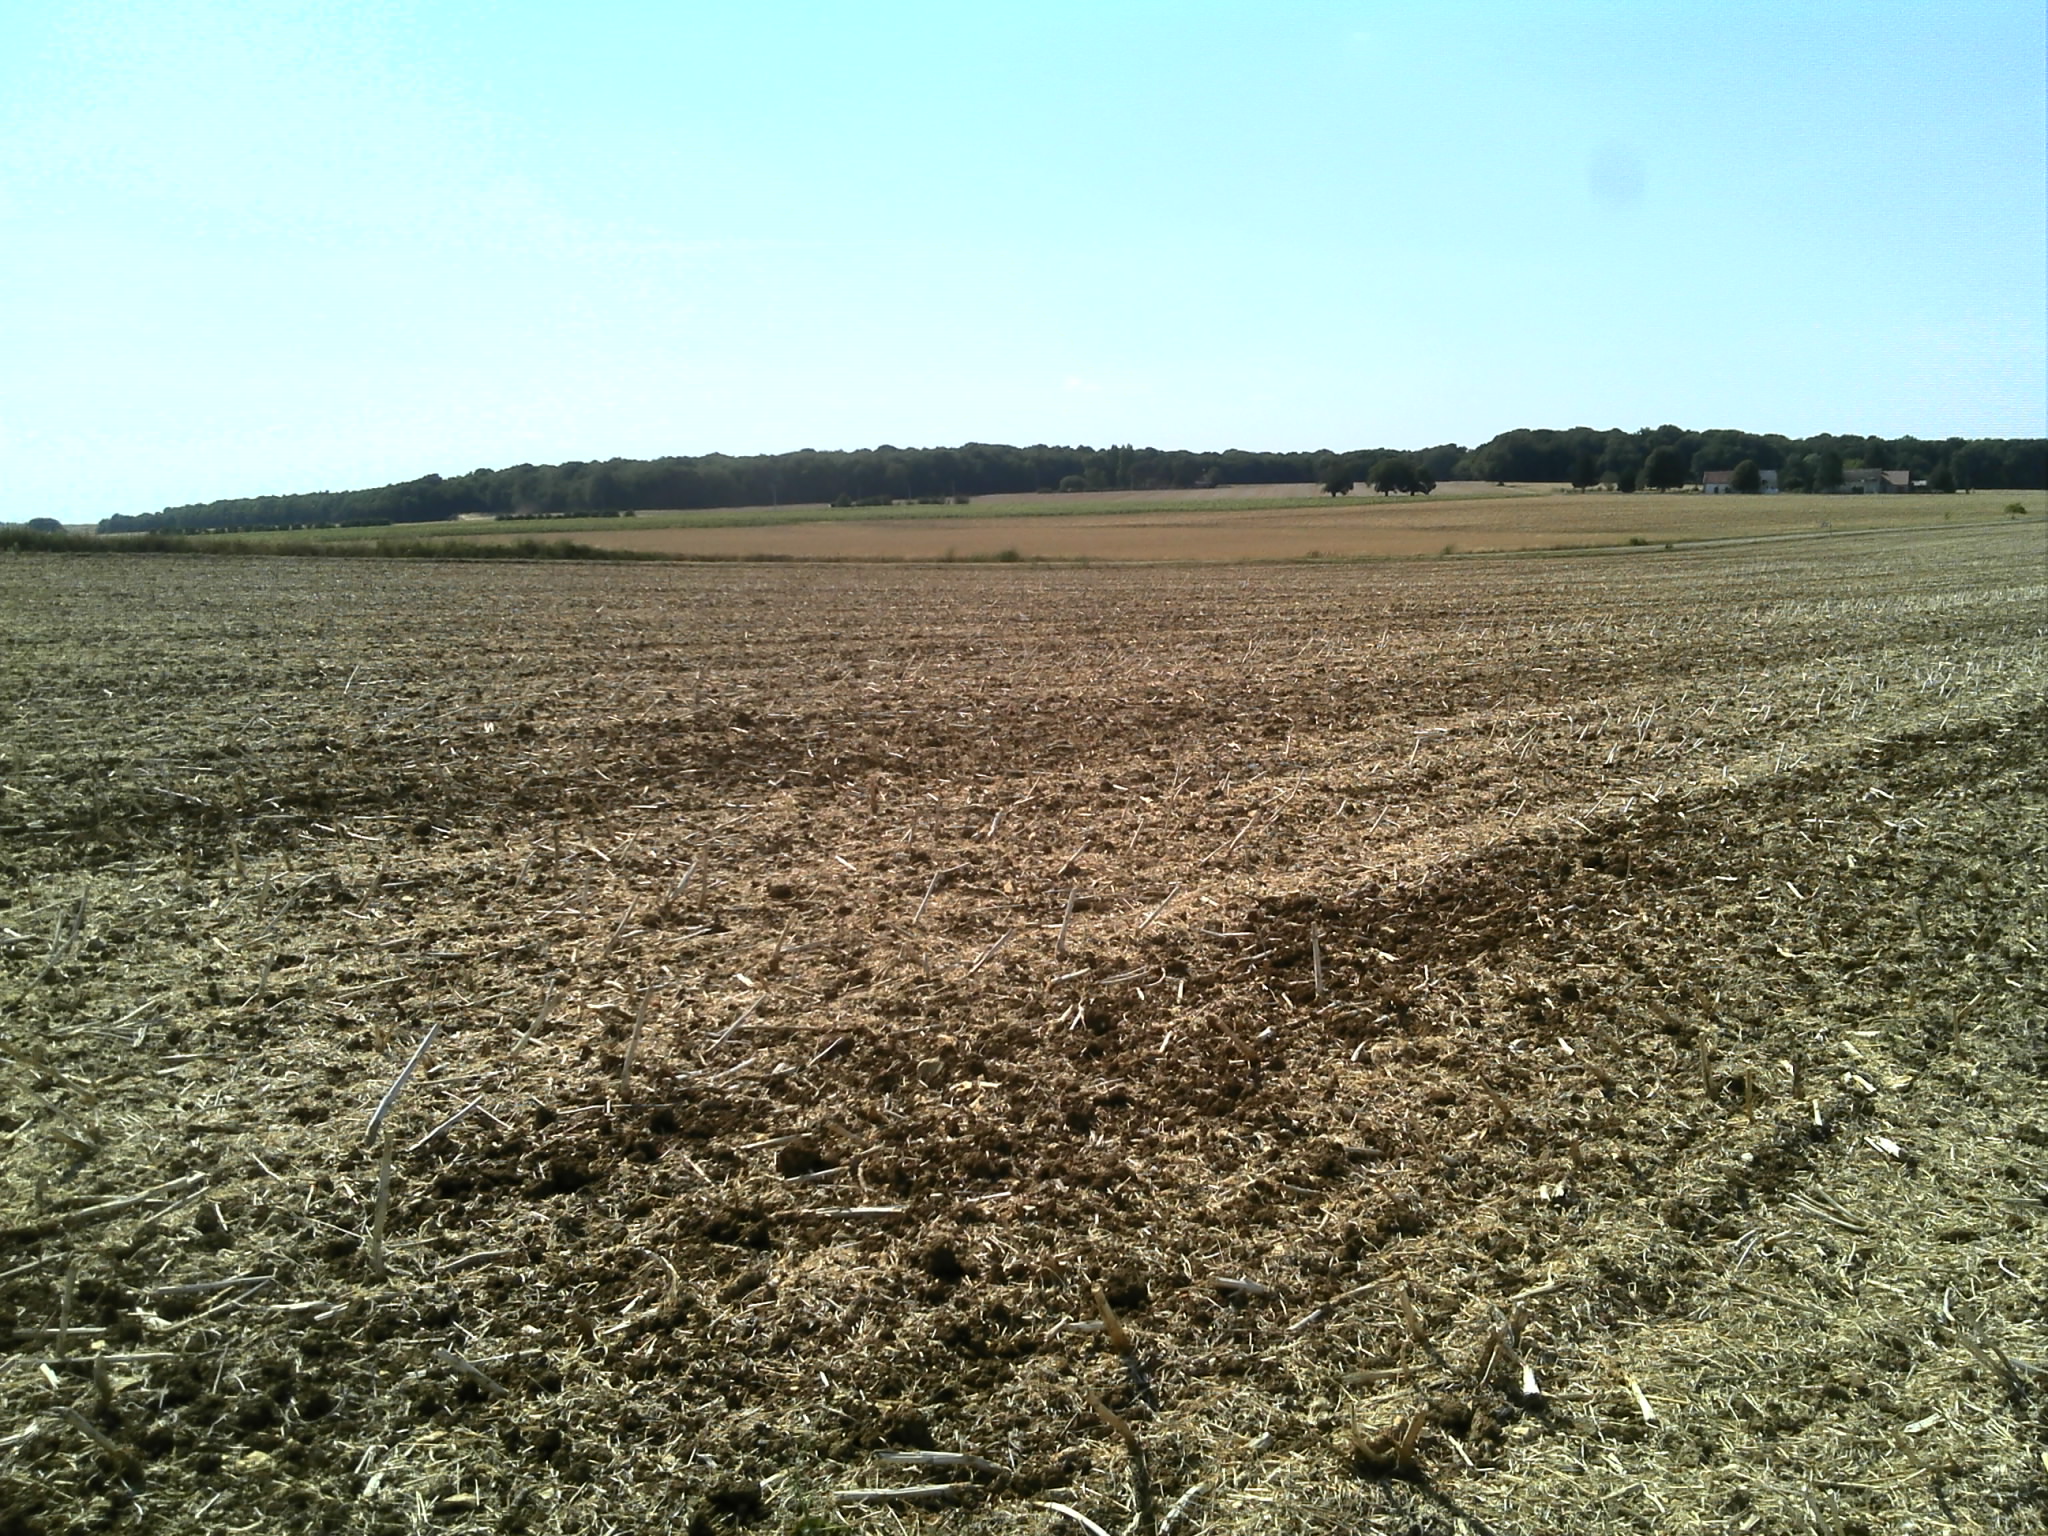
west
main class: Cropland
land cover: Rape and turnip rape
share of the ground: < 10 %
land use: Agriculture (excluding fallow land and kitchen gardens)
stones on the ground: < 10 %
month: August
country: FR
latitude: 46.9032
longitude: 1.5475
